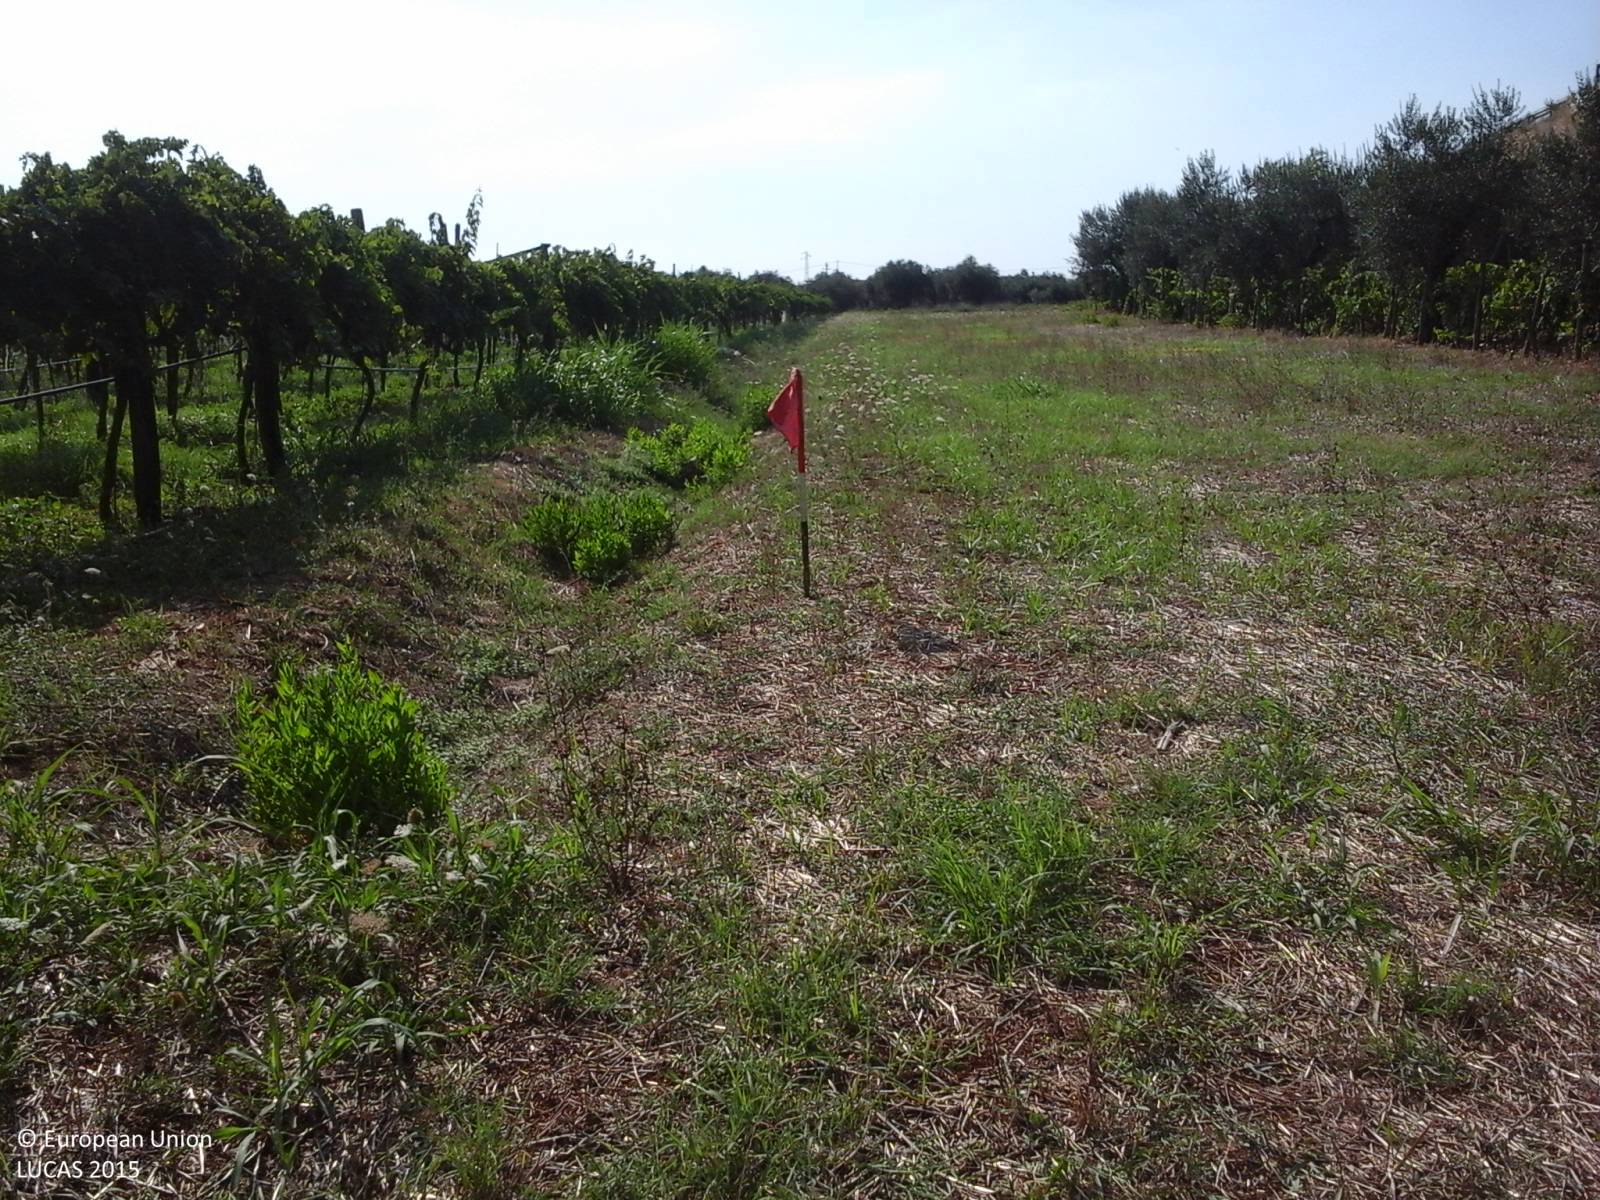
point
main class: Grassland
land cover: Spontaneously vegetated surfaces
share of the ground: > 75 %
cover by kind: herbaceous plants 100 %
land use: Agriculture (excluding fallow land and kitchen gardens)
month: August
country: IT
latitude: 41.3918
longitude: 13.2043
